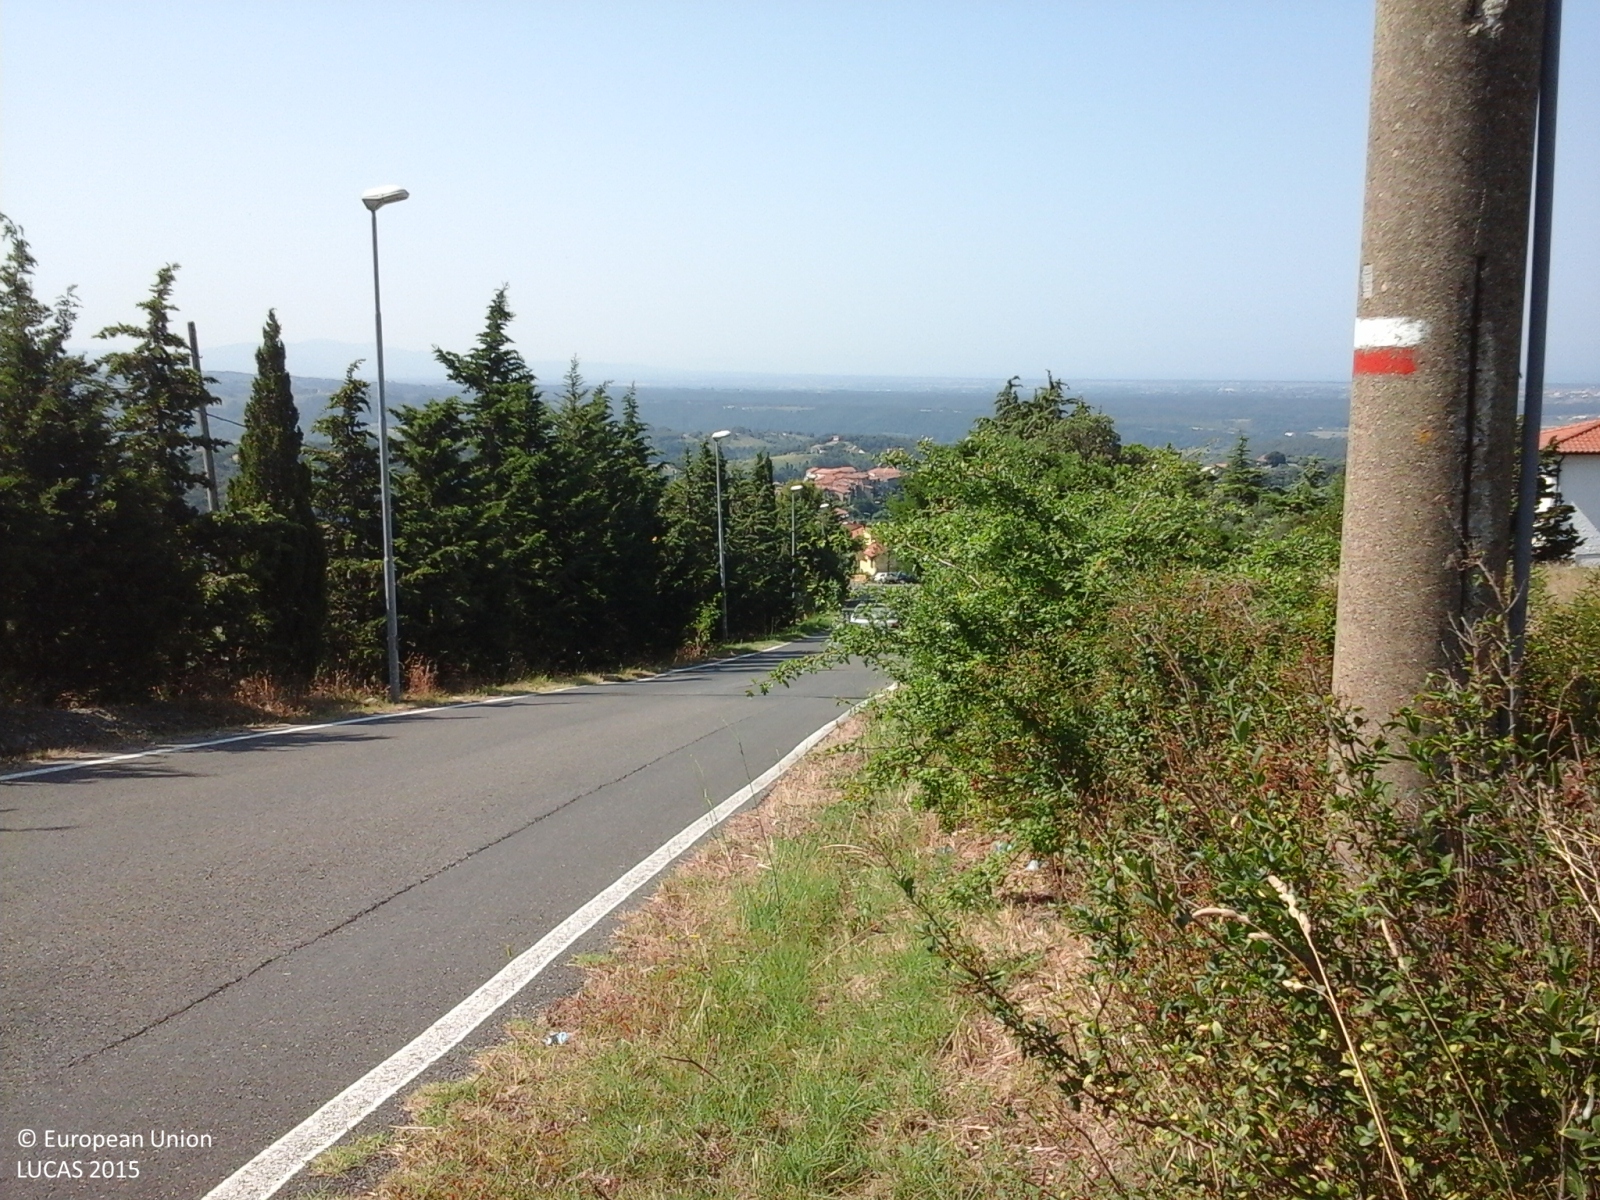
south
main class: Cropland
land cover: Temporary grasslands
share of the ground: > 75 %
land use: Agriculture (excluding fallow land and kitchen gardens)
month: August
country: IT
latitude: 43.3745
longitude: 10.6030
